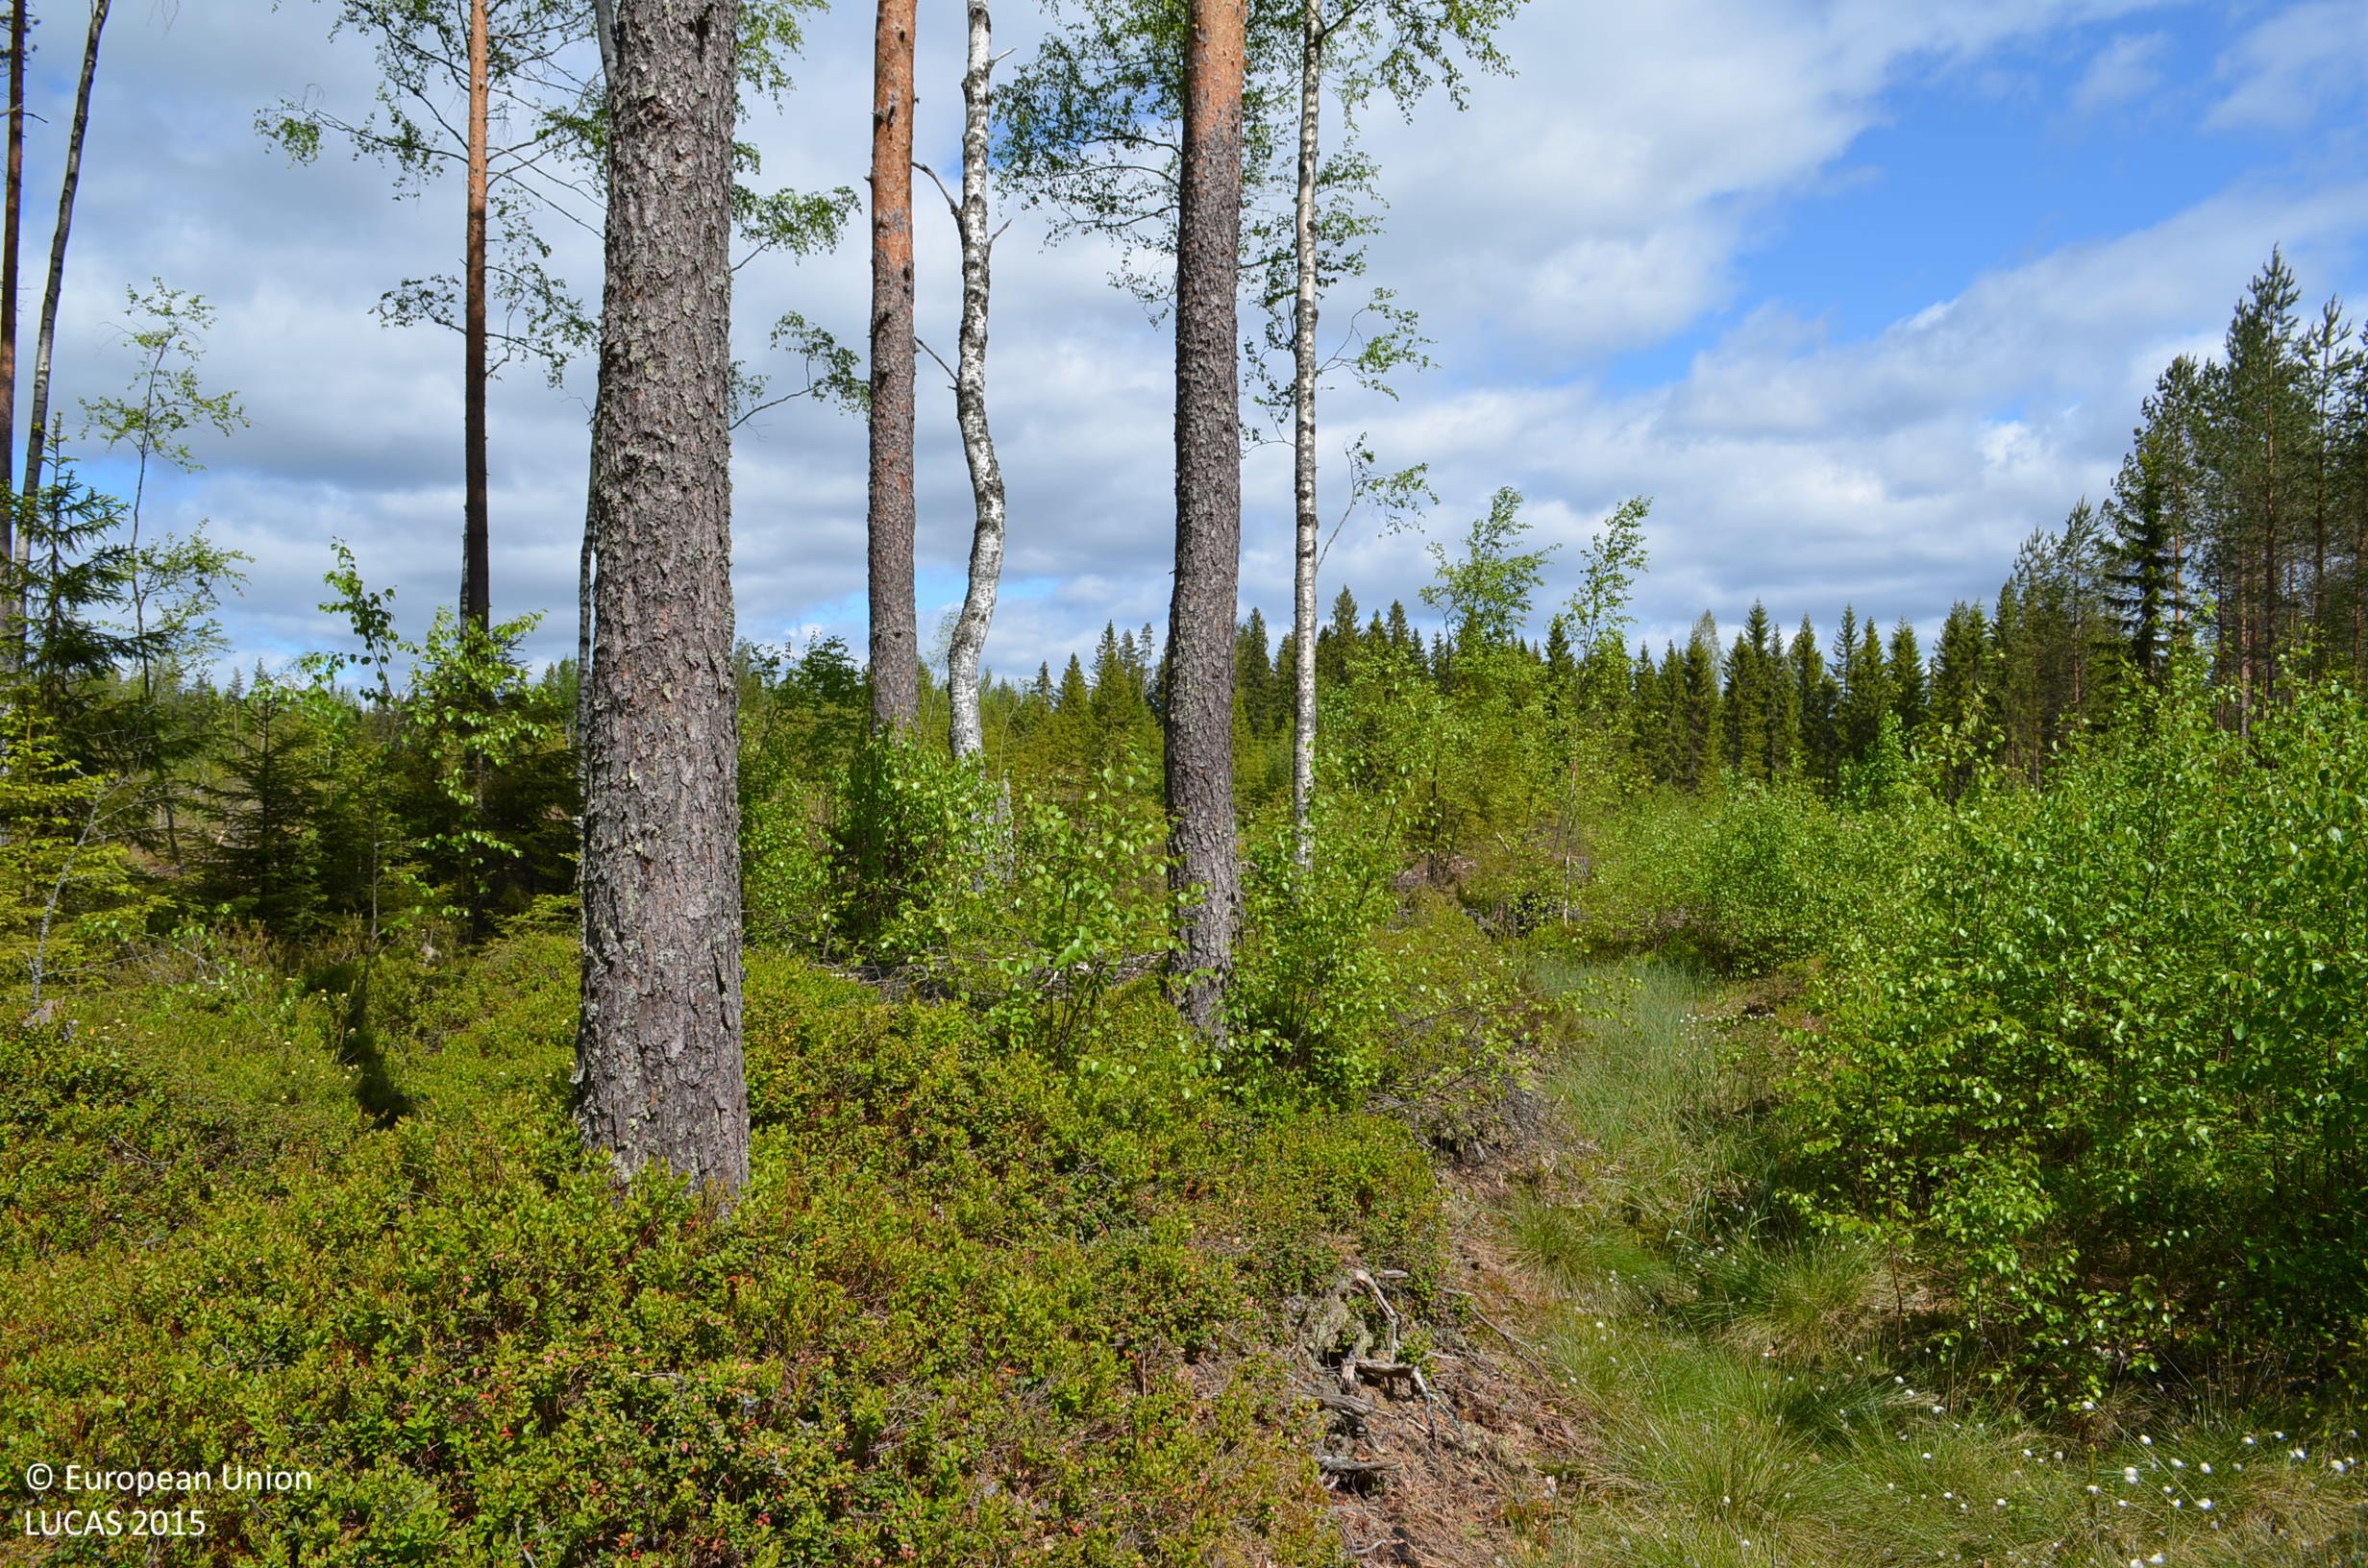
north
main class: Woodland
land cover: Pine dominated mixed woodland
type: boreal forest
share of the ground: 50 - 75 %
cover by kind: coniferous forest trees 50 %, shrubs 30 %, broadleaved forest trees 20 %
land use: Forestry
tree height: > 5 m
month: June
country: FI
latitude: 61.8339
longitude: 23.1168
